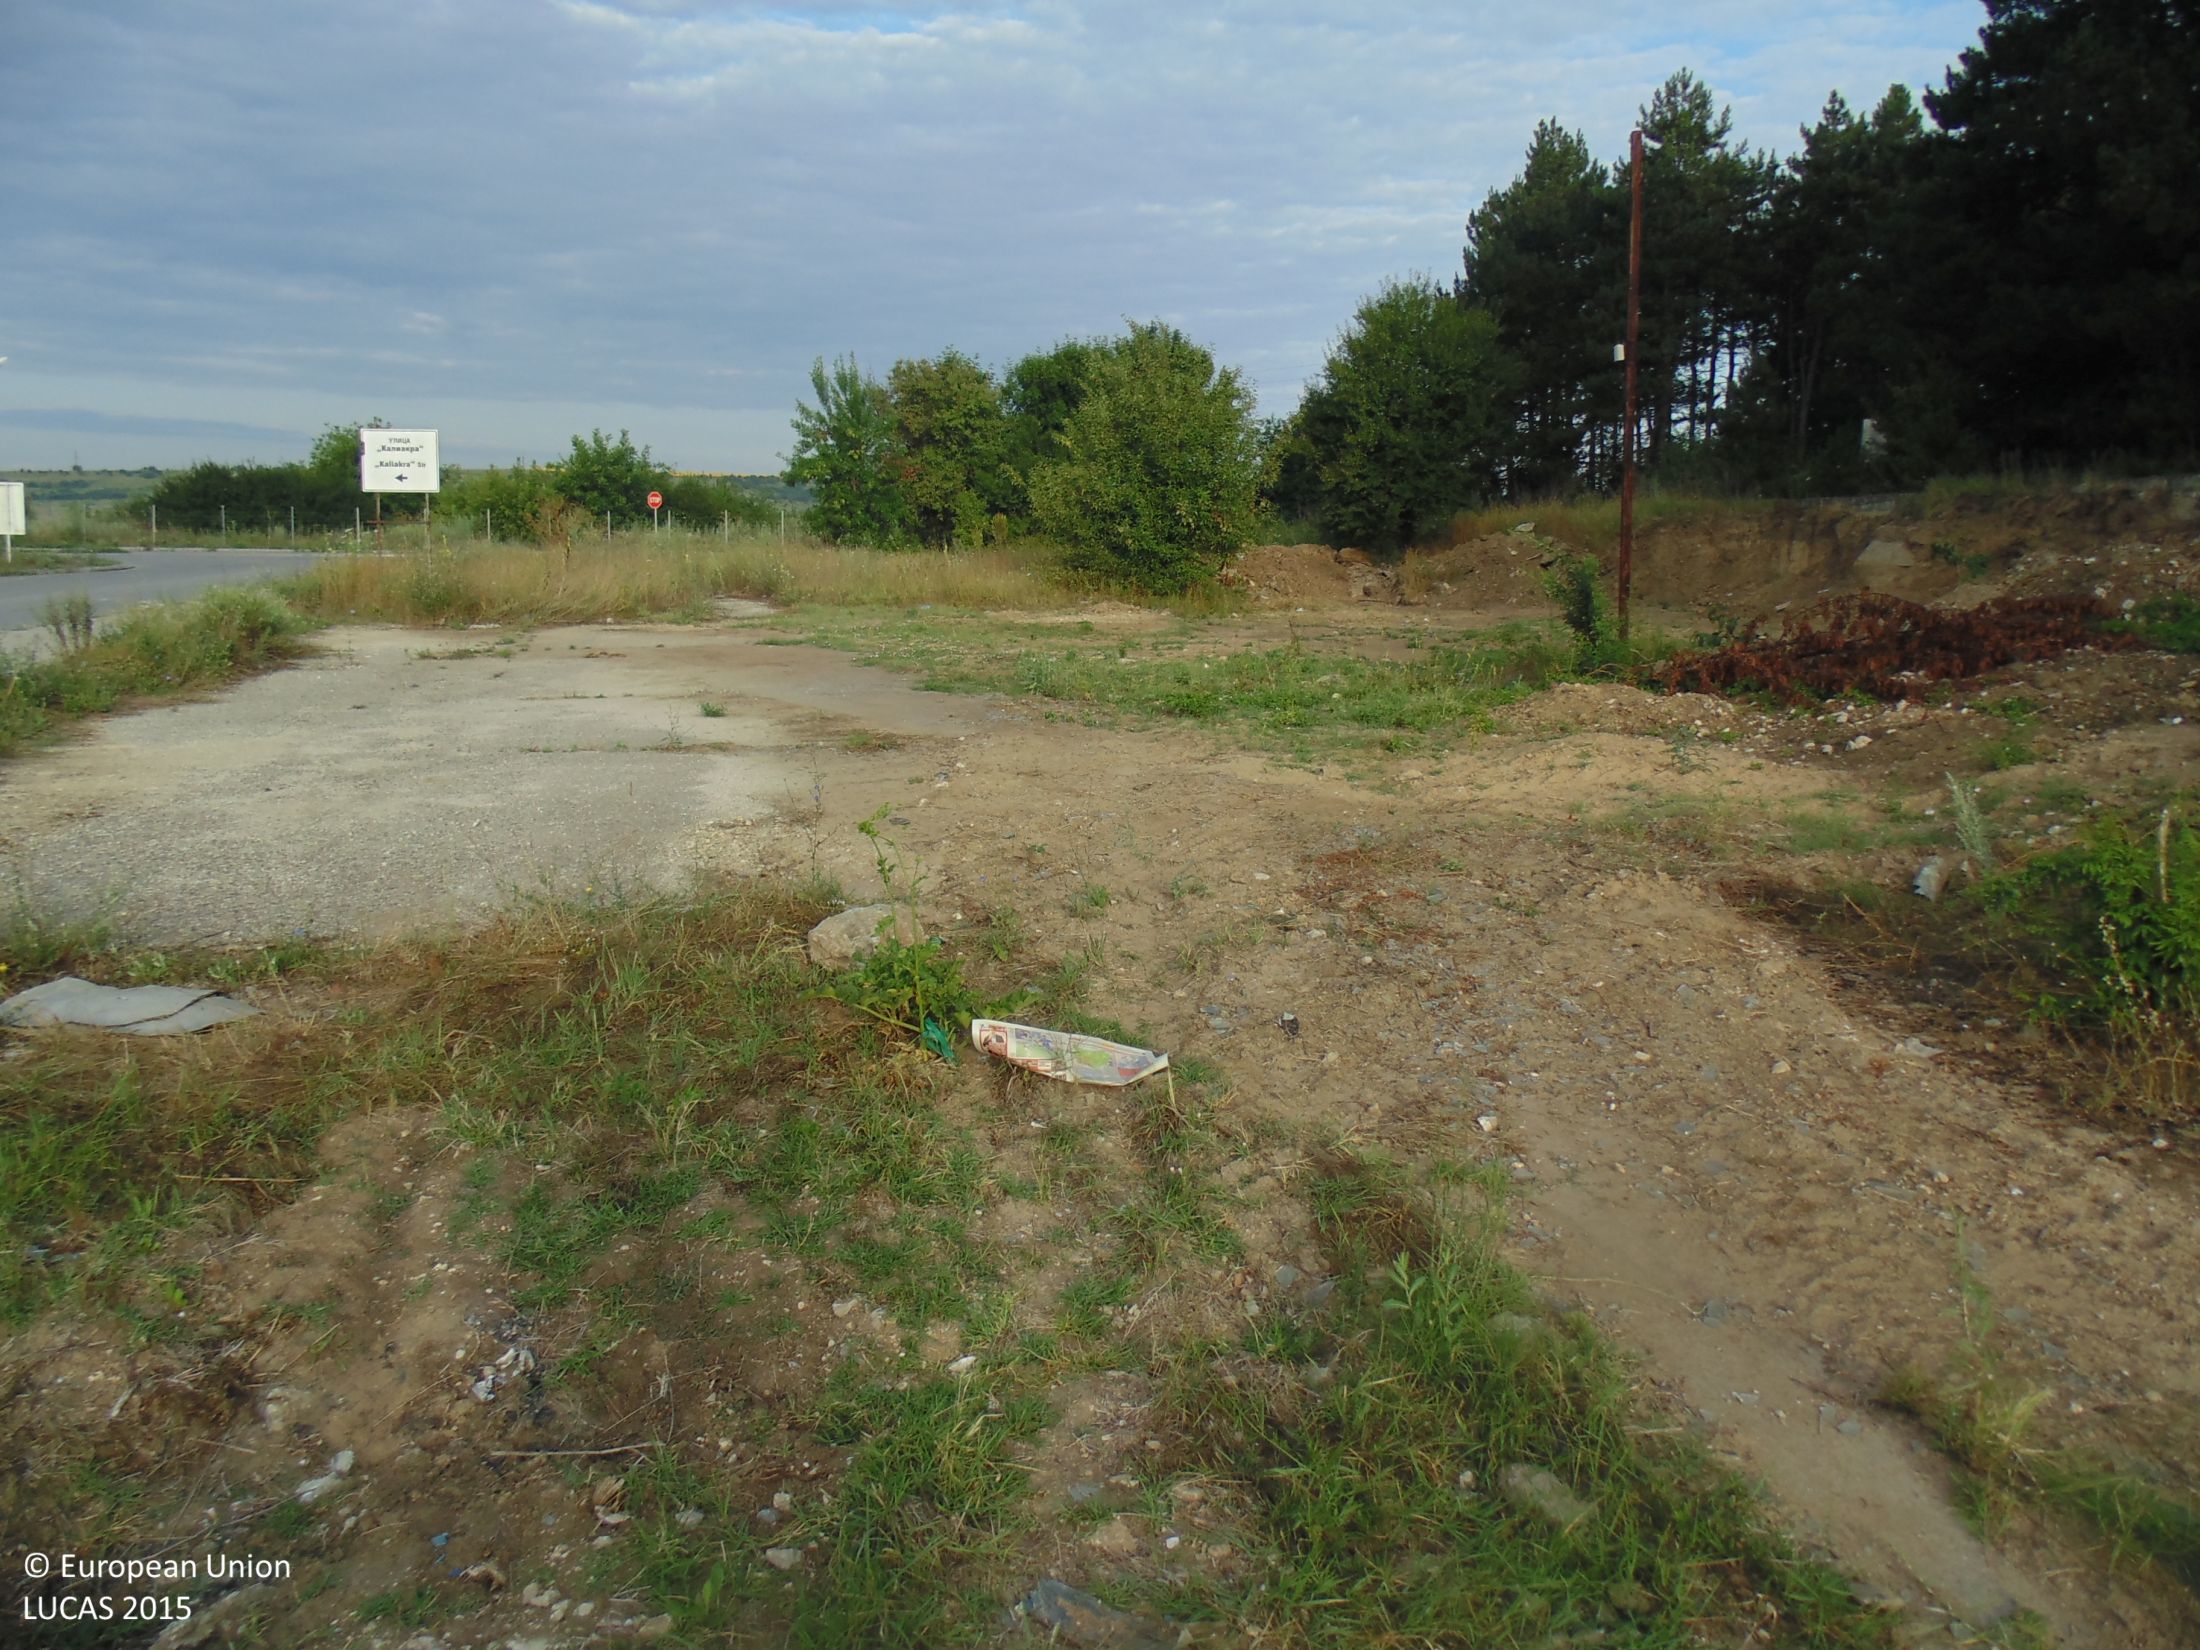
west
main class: Grassland
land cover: Grassland with sparse tree/shrub cover
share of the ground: > 75 %
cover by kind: herbaceous plants 90 %, broadleaved forest trees 5 %, shrubs 5 %
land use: Road transport
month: July
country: BG
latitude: 43.5865
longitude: 27.8148
